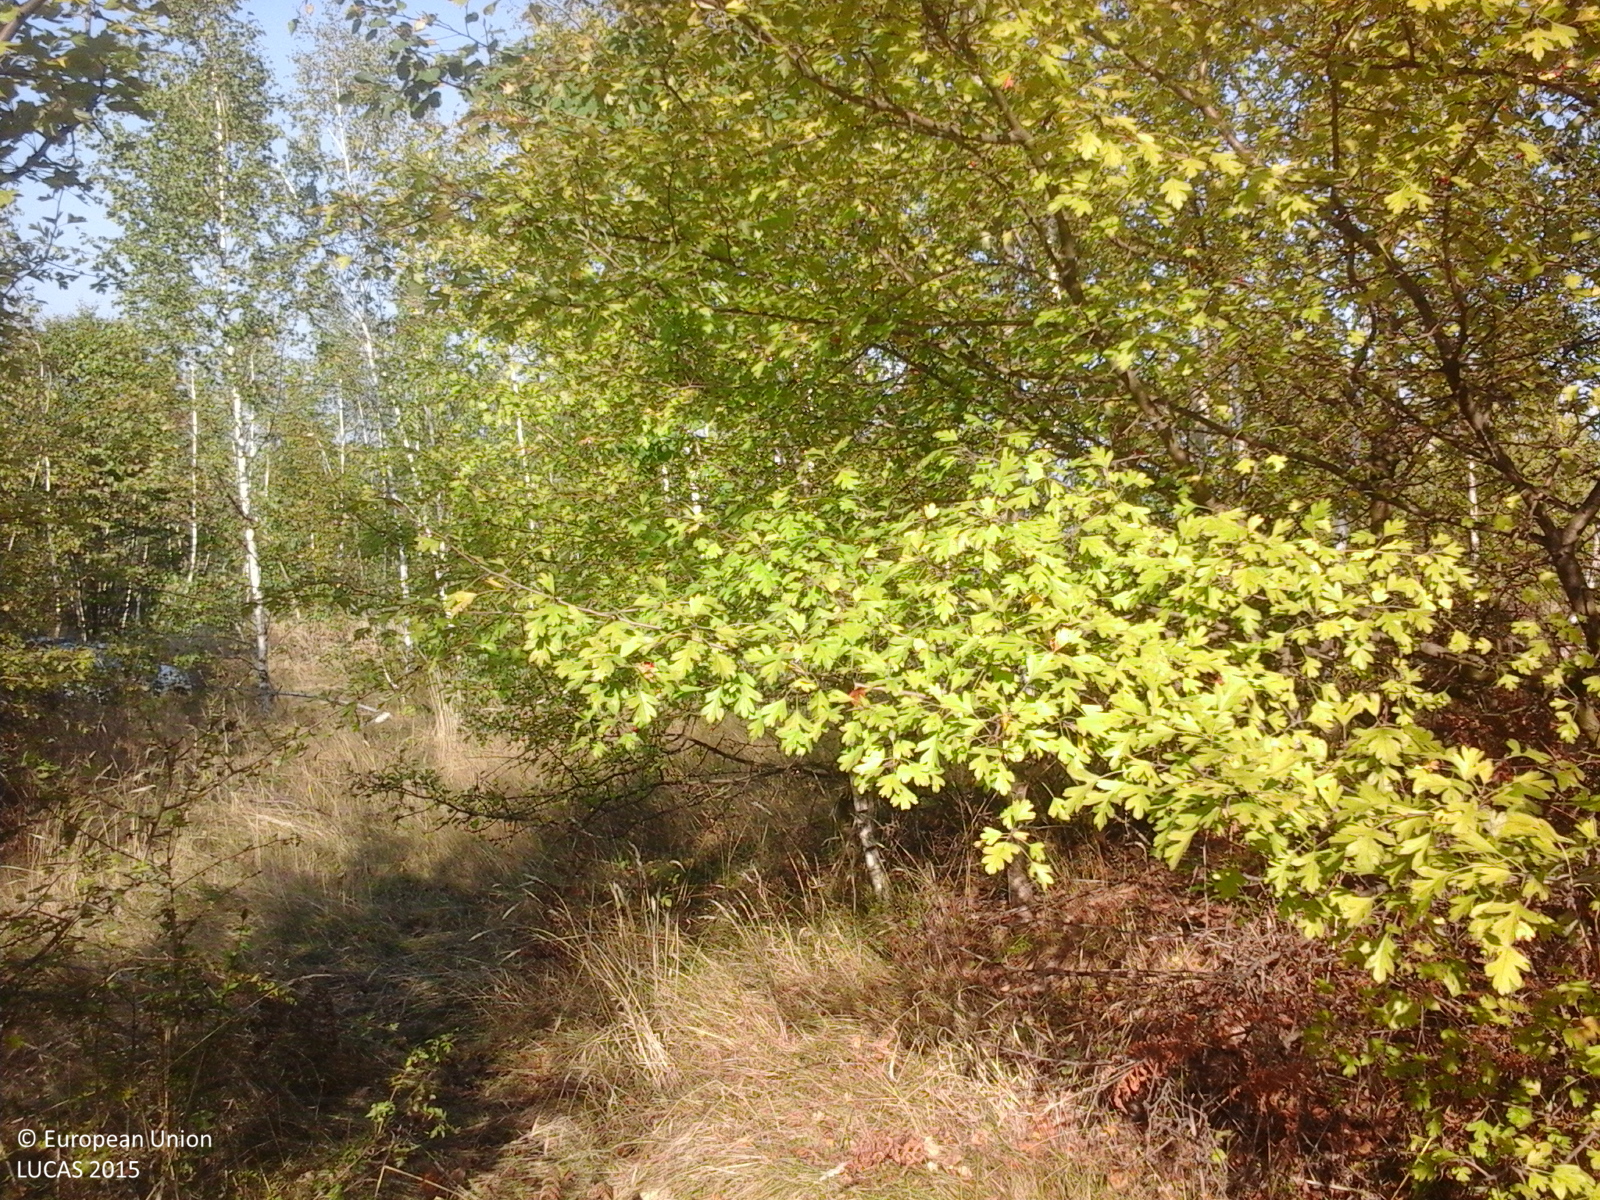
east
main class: Woodland
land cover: Broadleaved woodland
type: non-riverine alder, birch or aspen forest
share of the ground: > 75 %
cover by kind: broadleaved forest trees 100 %
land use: Forestry
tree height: > 5 m
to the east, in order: Broadleaved woodland; Tracks; Broadleaved woodland; Fences; Other fruit trees and berries; Artificial constructions in urban areas
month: September
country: RO
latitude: 45.2810
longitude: 22.2404
